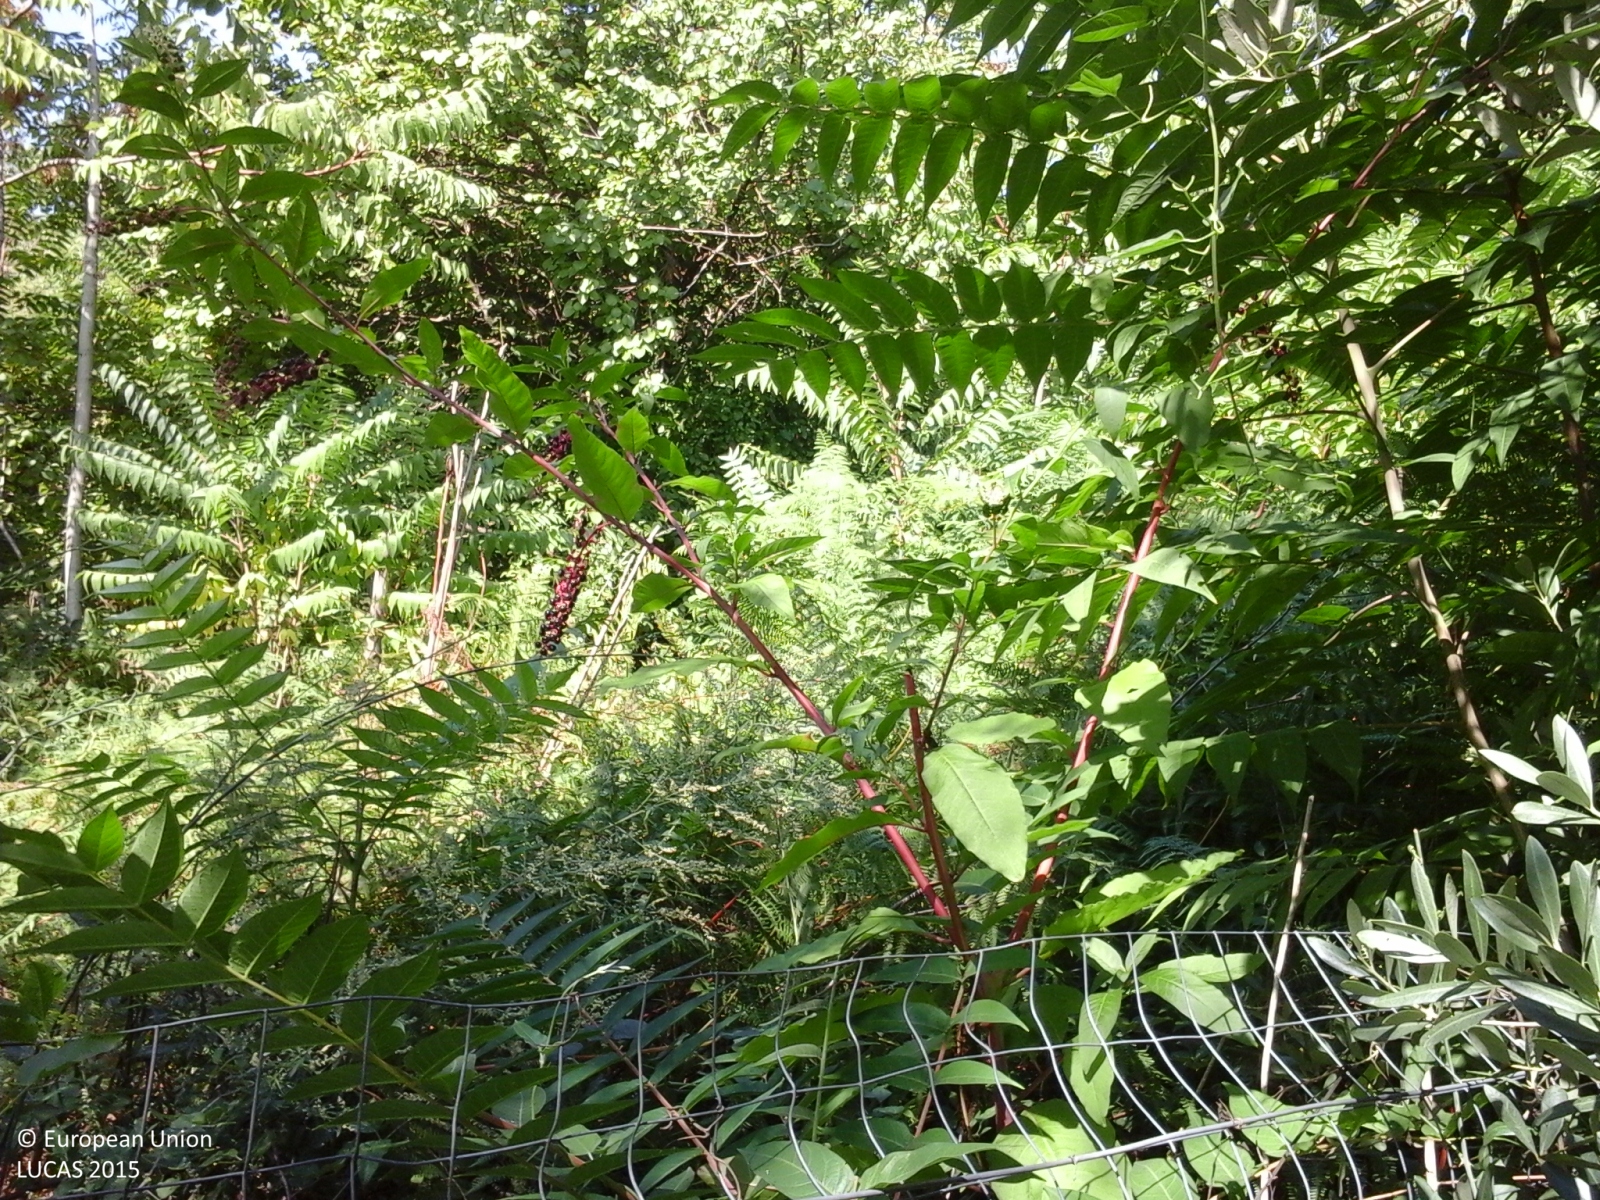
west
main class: Woodland
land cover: Broadleaved woodland
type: exotic forest
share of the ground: > 75 %
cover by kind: broadleaved forest trees 100 %
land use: Semi-natural and natural areas not in use
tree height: > 5 m
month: August
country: IT
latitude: 40.7536
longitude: 14.6829
